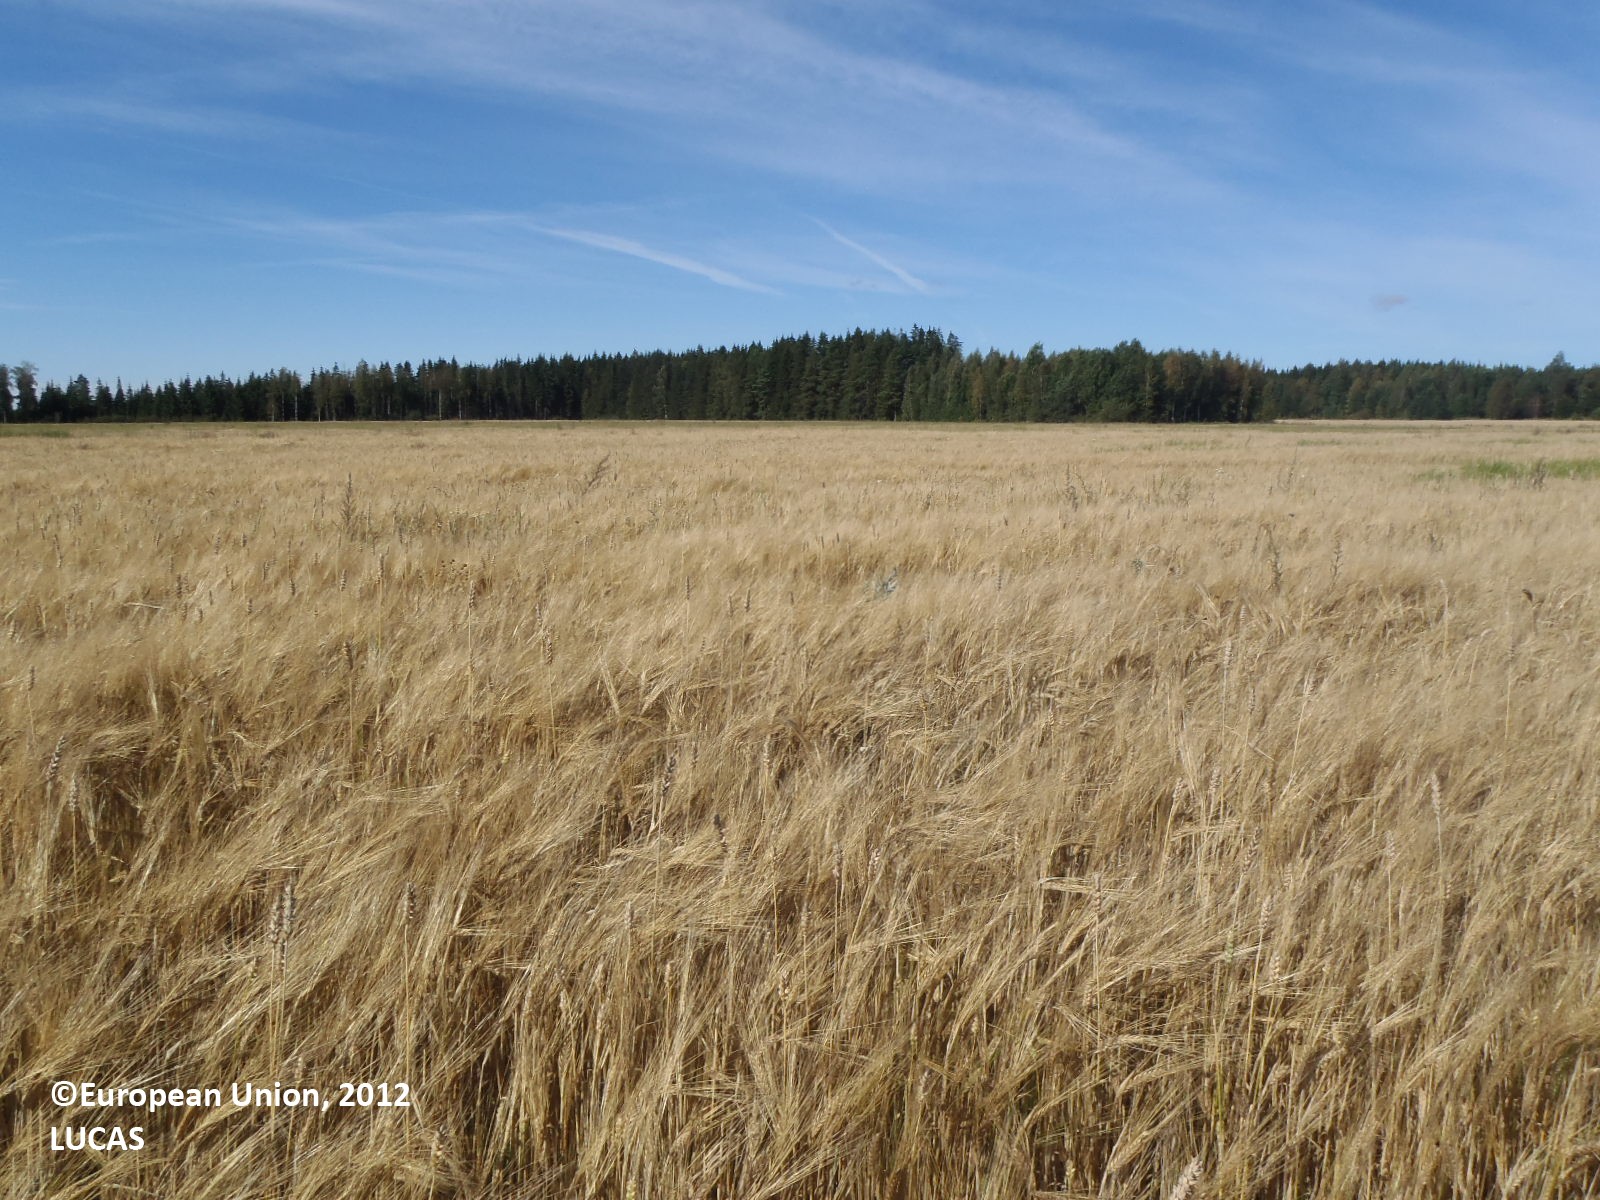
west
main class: Cropland
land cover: Common wheat
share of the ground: 25 - 50 %
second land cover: Barley
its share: 50 - 75 %
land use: Agriculture (excluding fallow land and kitchen gardens)
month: September
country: FI
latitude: 61.0808
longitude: 22.3173
